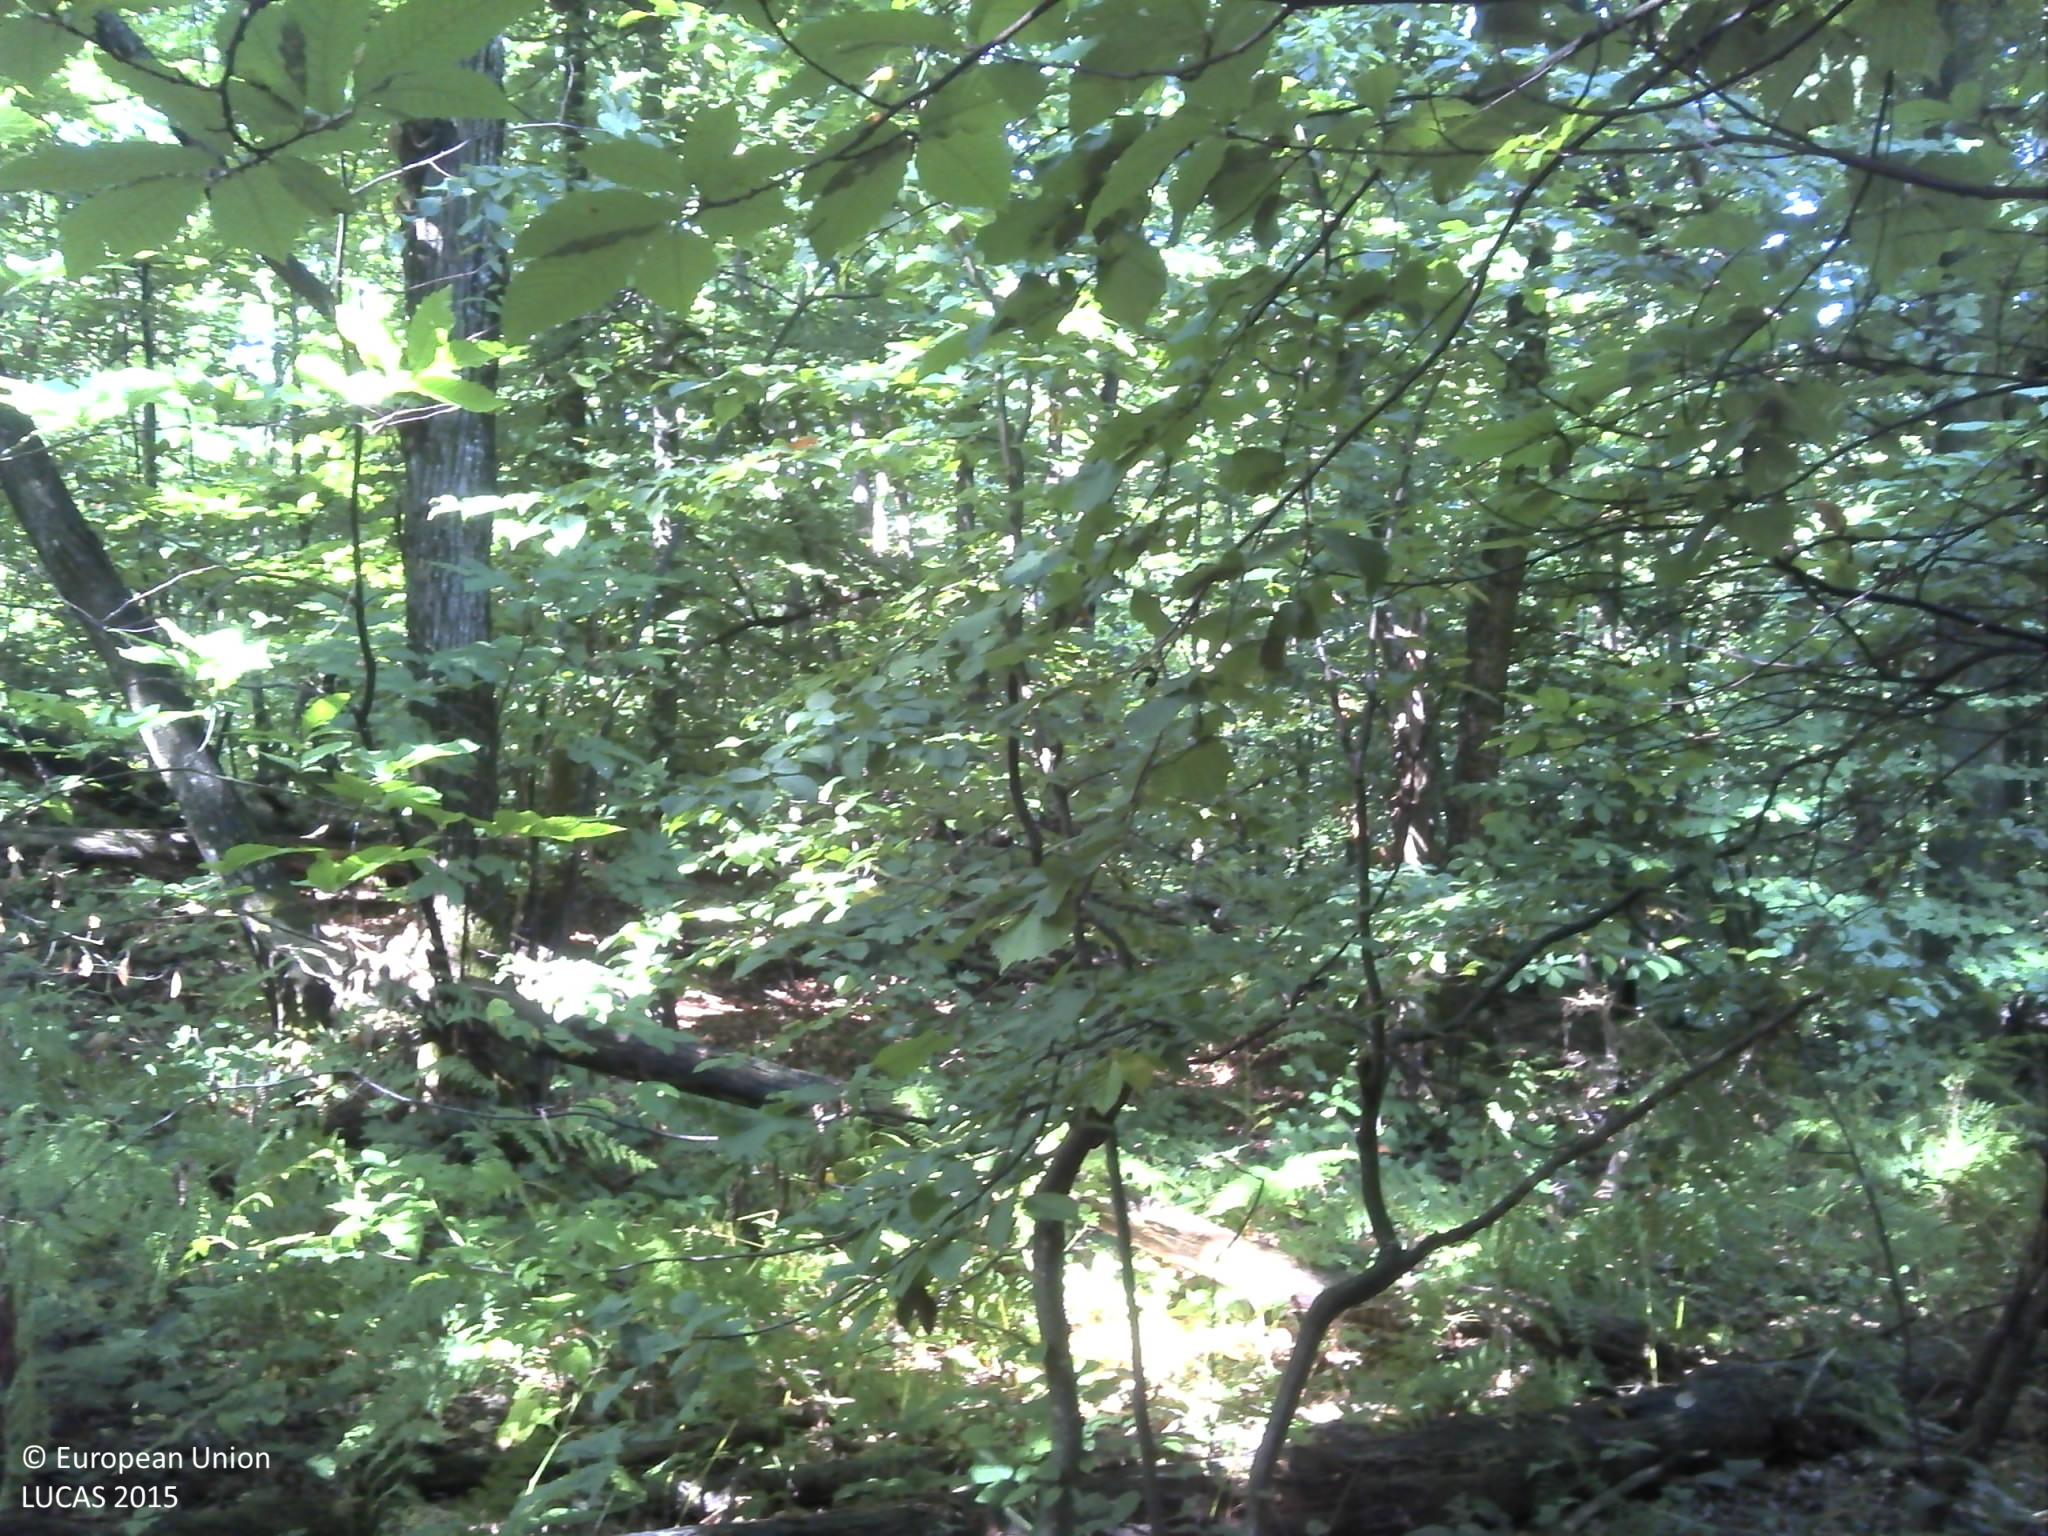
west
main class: Woodland
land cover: Broadleaved woodland
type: beech forest
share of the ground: > 75 %
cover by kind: broadleaved forest trees 100 %
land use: Forestry
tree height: > 5 m
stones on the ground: < 10 %
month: August
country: HR
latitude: 45.2048
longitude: 16.3498
